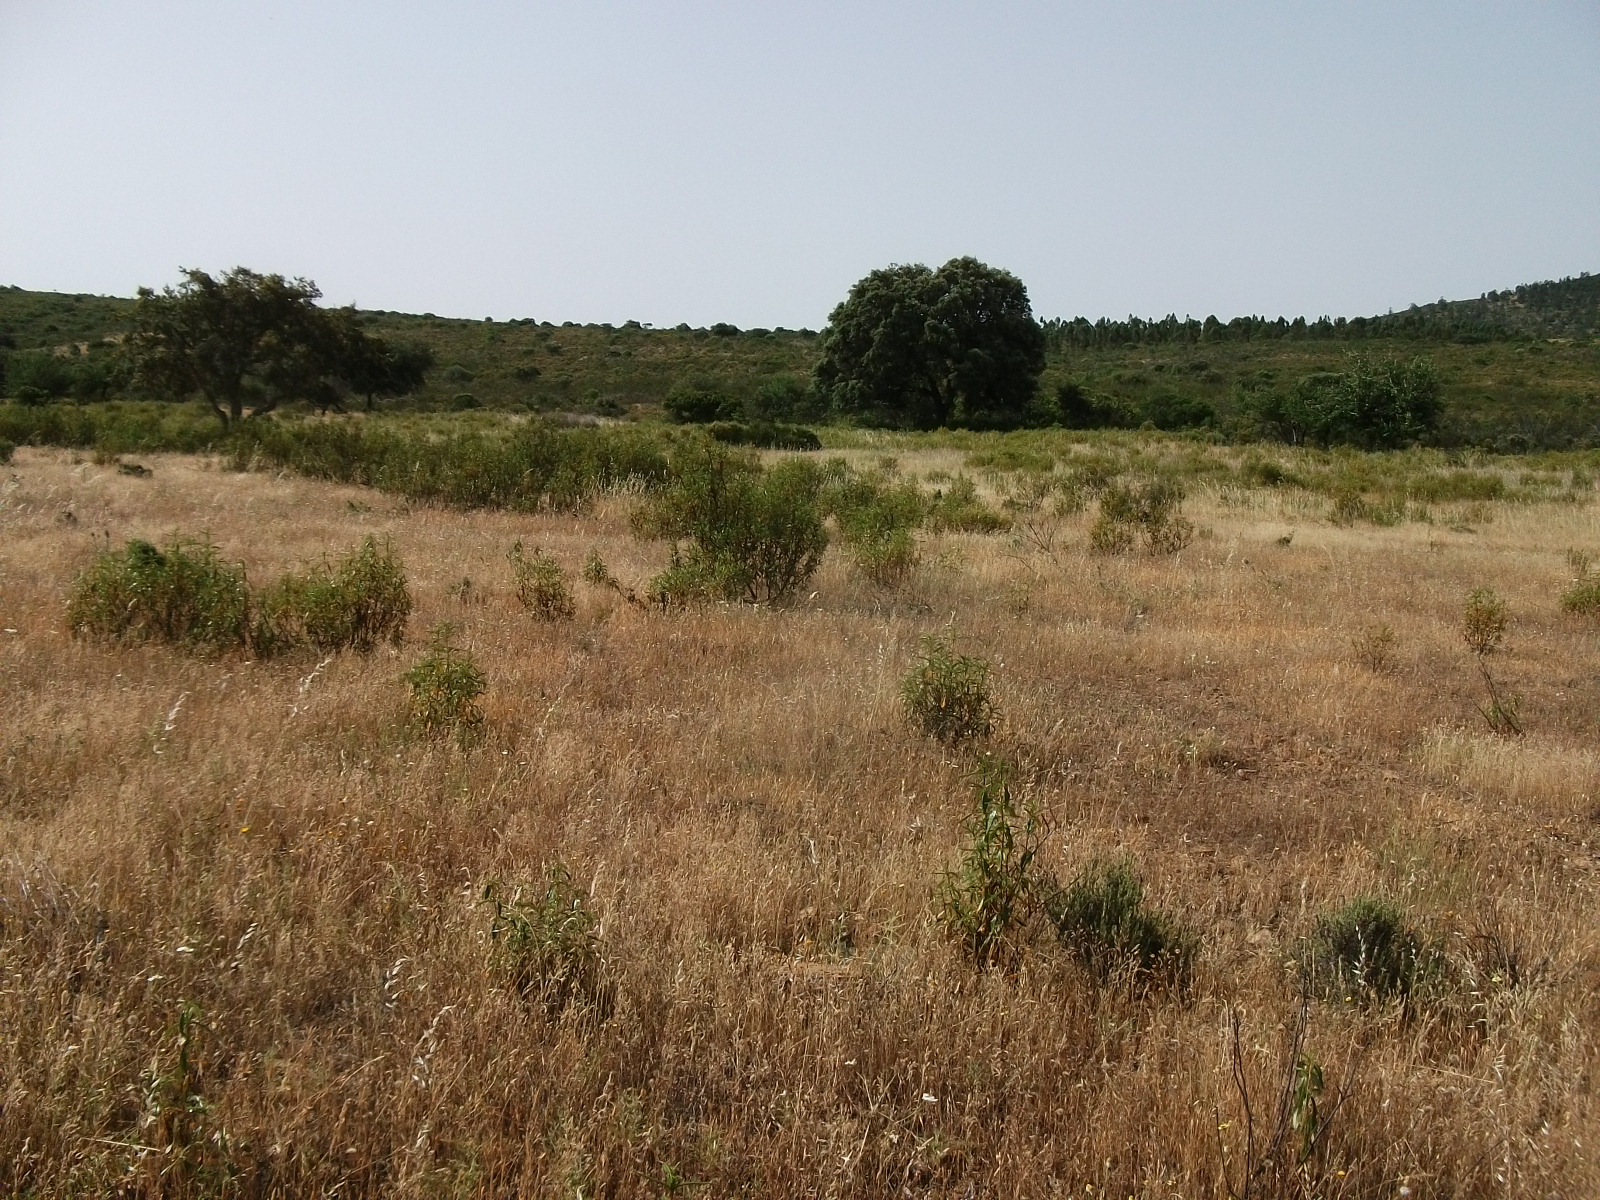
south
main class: Grassland
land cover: Grassland with sparse tree/shrub cover
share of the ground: > 75 %
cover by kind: herbaceous plants 90 %, broadleaved forest trees 5 %, shrubs 5 %
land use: Agriculture (excluding fallow land and kitchen gardens)
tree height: < 5 m
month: May
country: ES
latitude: 37.7492
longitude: -7.0399
